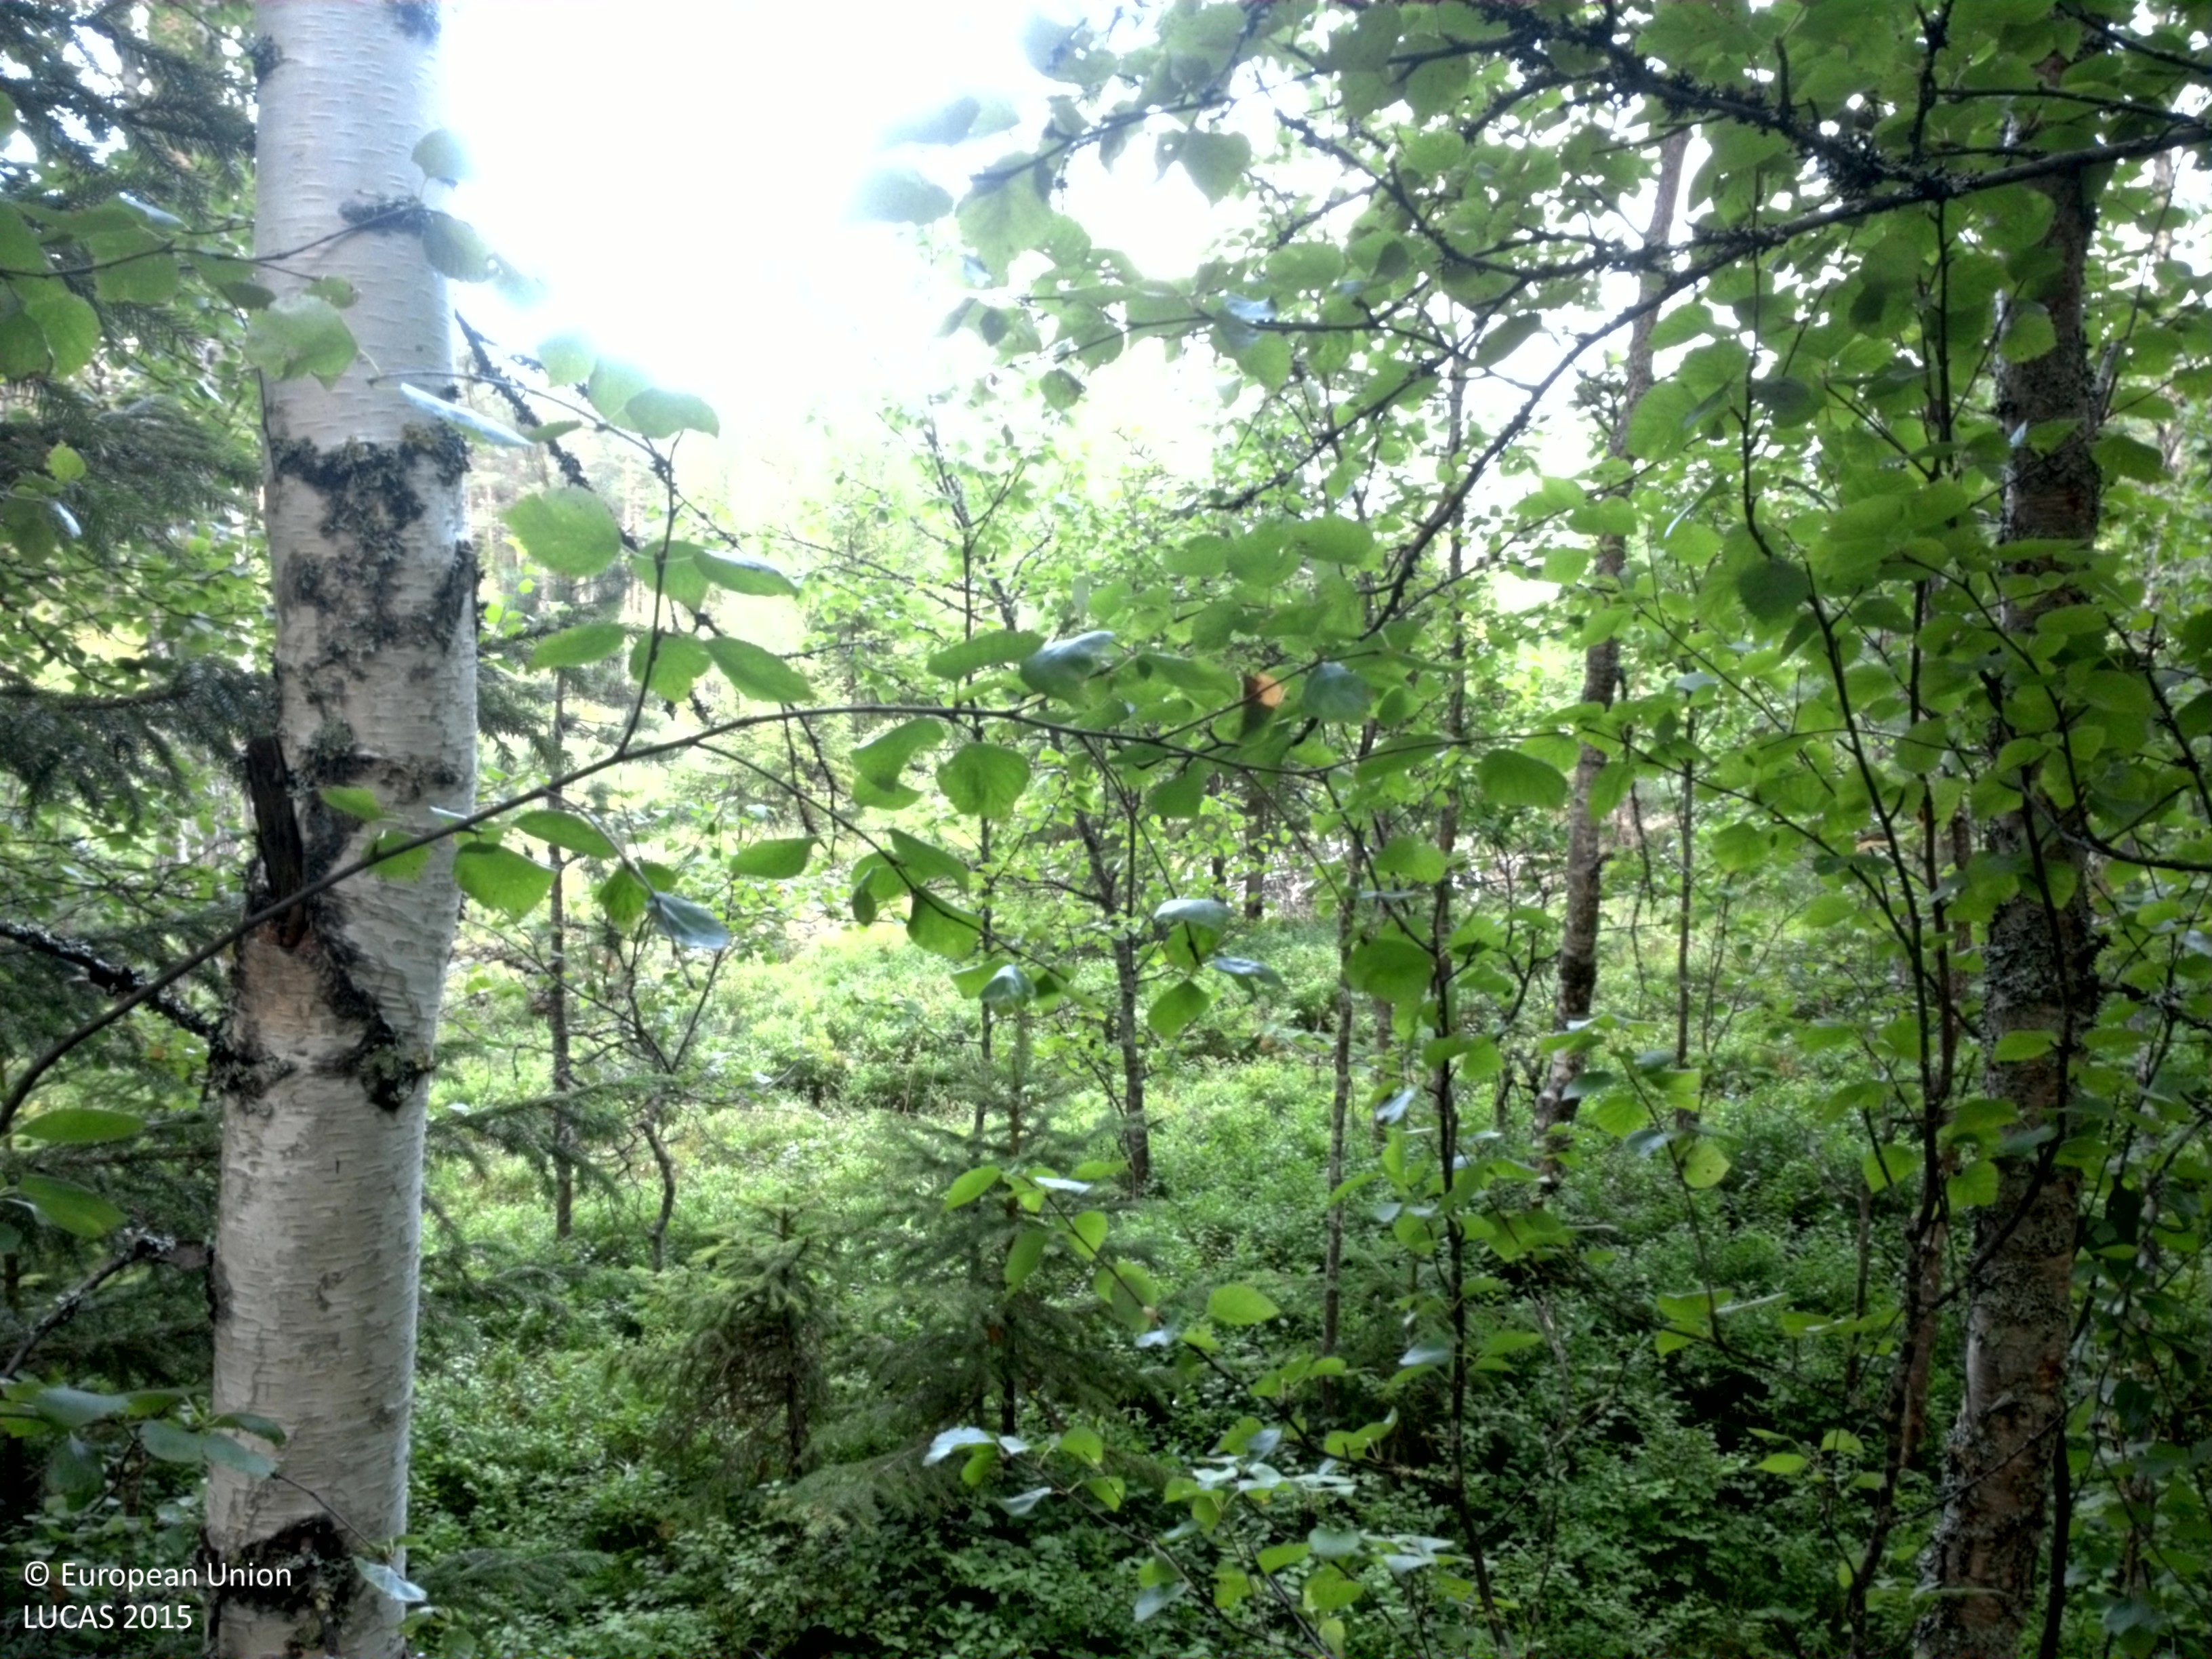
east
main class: Woodland
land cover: Other mixed woodland
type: boreal forest
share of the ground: 50 - 75 %
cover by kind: coniferous forest trees 45 %, broadleaved forest trees 30 %, shrubs 20 %, lichens and mosses 5 %
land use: Forestry
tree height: > 5 m
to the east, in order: Other mixed woodland; Broadleaved woodland; Pine dominated coniferous woodland; Spruce dominated coniferous woodland; Grassland without tree/shrub cover
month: August
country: SE
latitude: 64.6402
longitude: 20.6700
